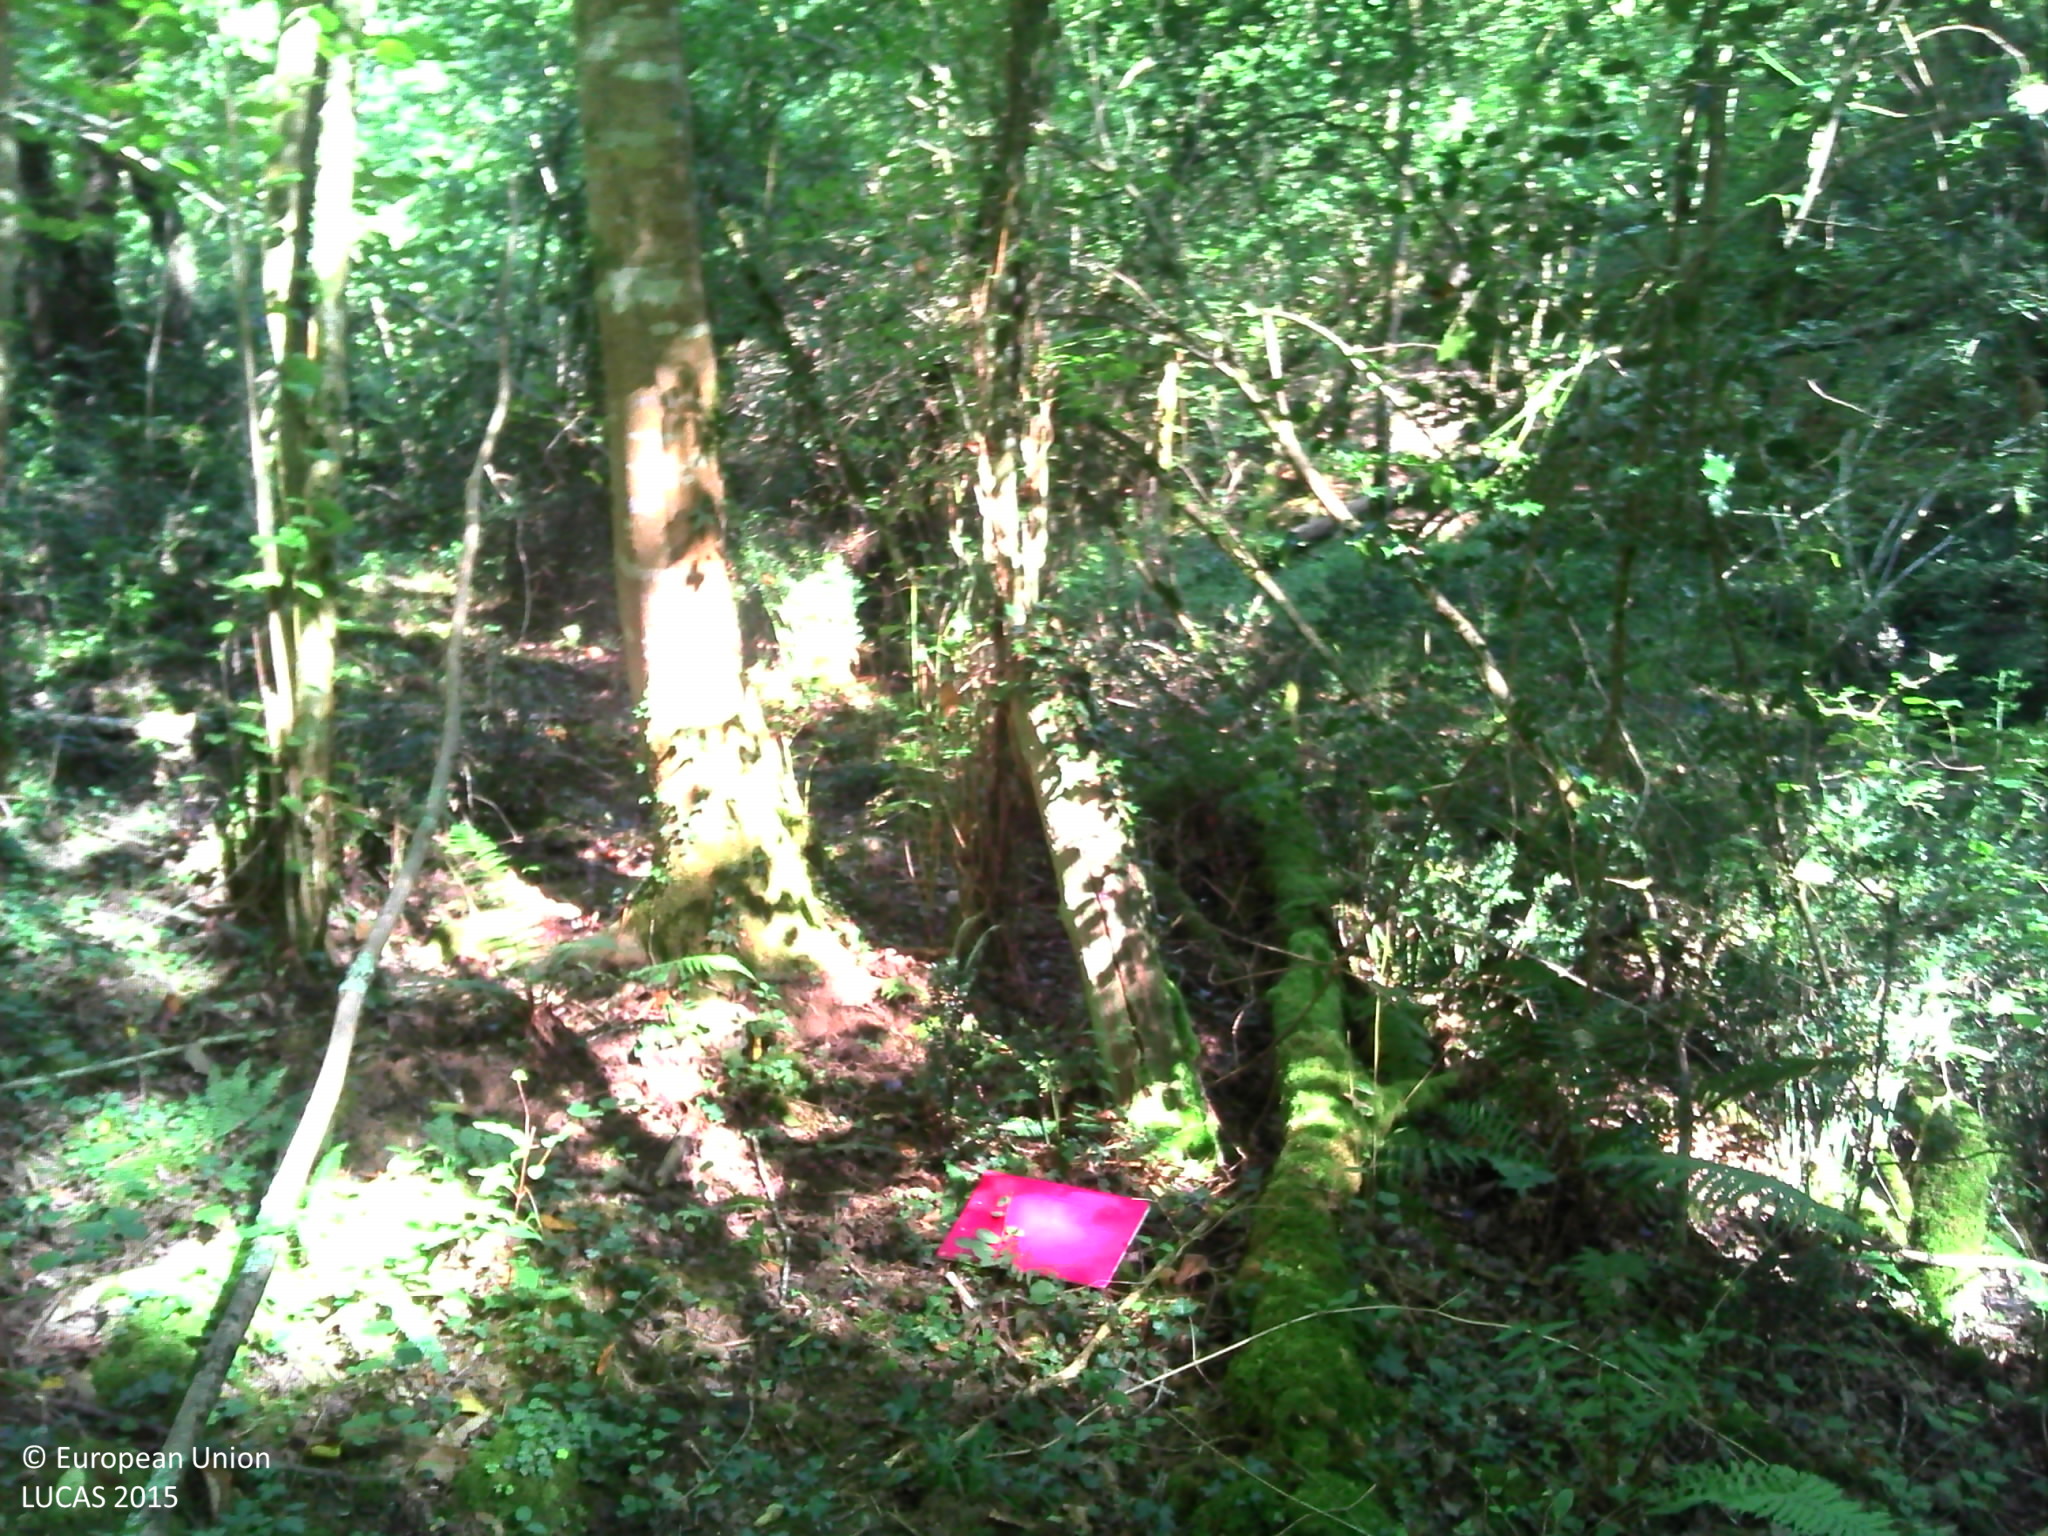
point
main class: Woodland
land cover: Broadleaved woodland
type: mesophytic deciduous forest
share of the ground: 50 - 75 %
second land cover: Spontaneously vegetated surfaces
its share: 25 - 50 %
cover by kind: broadleaved forest trees 70 %, herbaceous plants 15 %, shrubs 10 %, lichens and mosses 5 %
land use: Agriculture (excluding fallow land and kitchen gardens)
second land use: Forestry
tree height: > 5 m
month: September
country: FR
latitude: 43.2837
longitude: -1.0669
